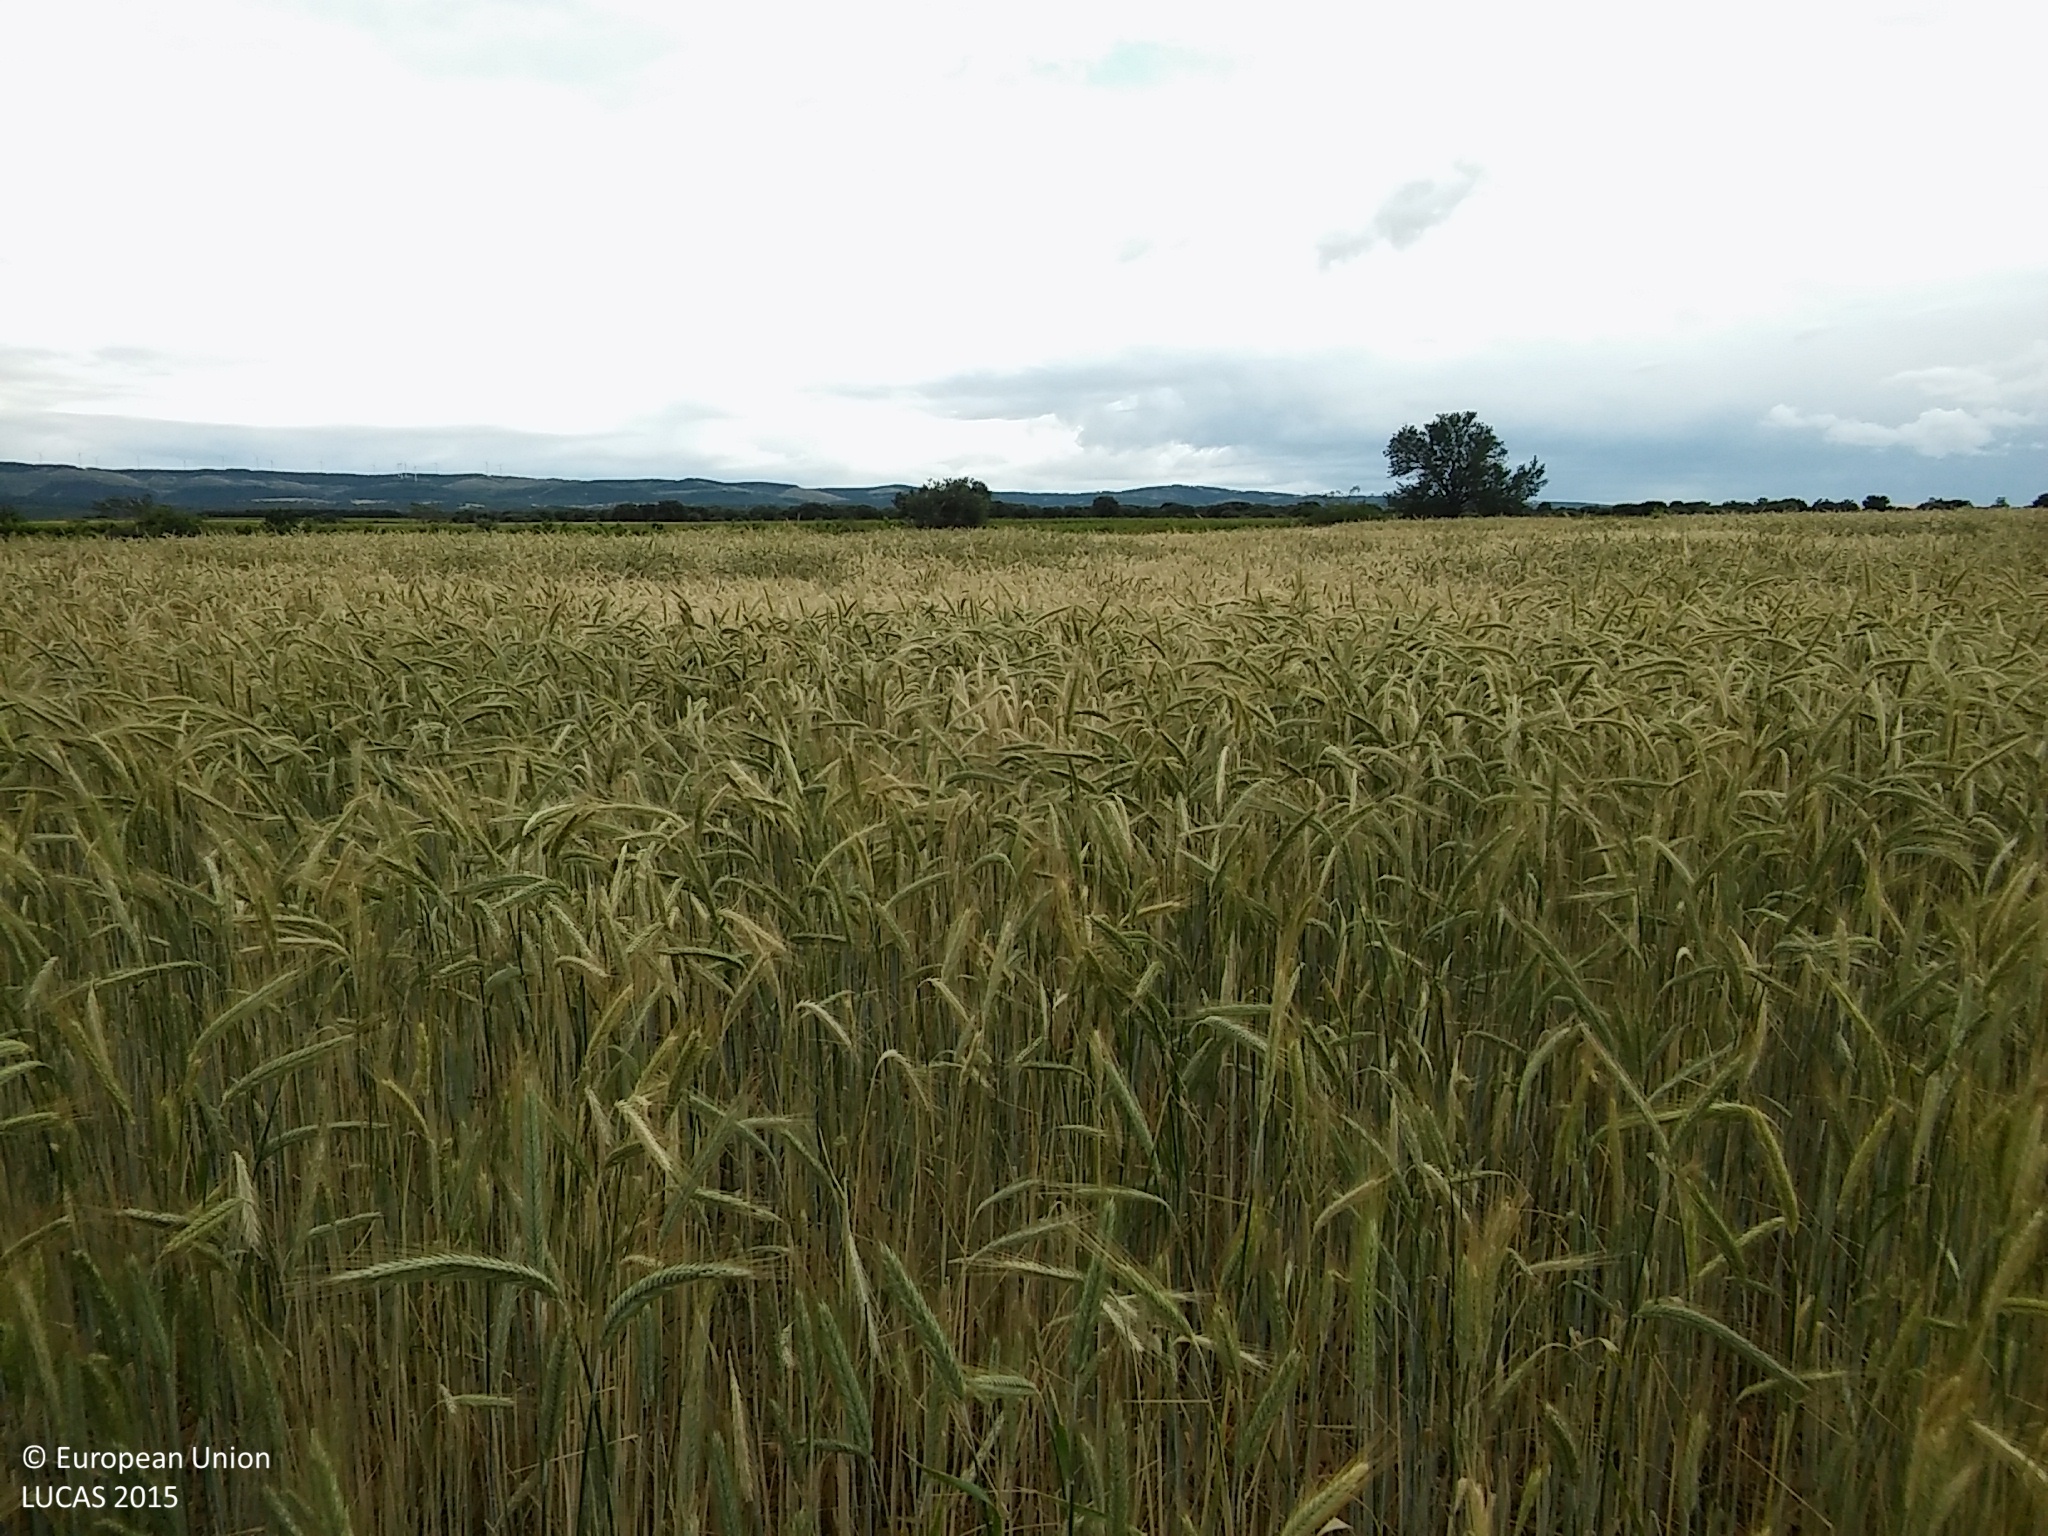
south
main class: Cropland
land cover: Rye
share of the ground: > 75 %
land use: Agriculture (excluding fallow land and kitchen gardens)
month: June
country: ES
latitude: 41.5217
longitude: -3.7976
